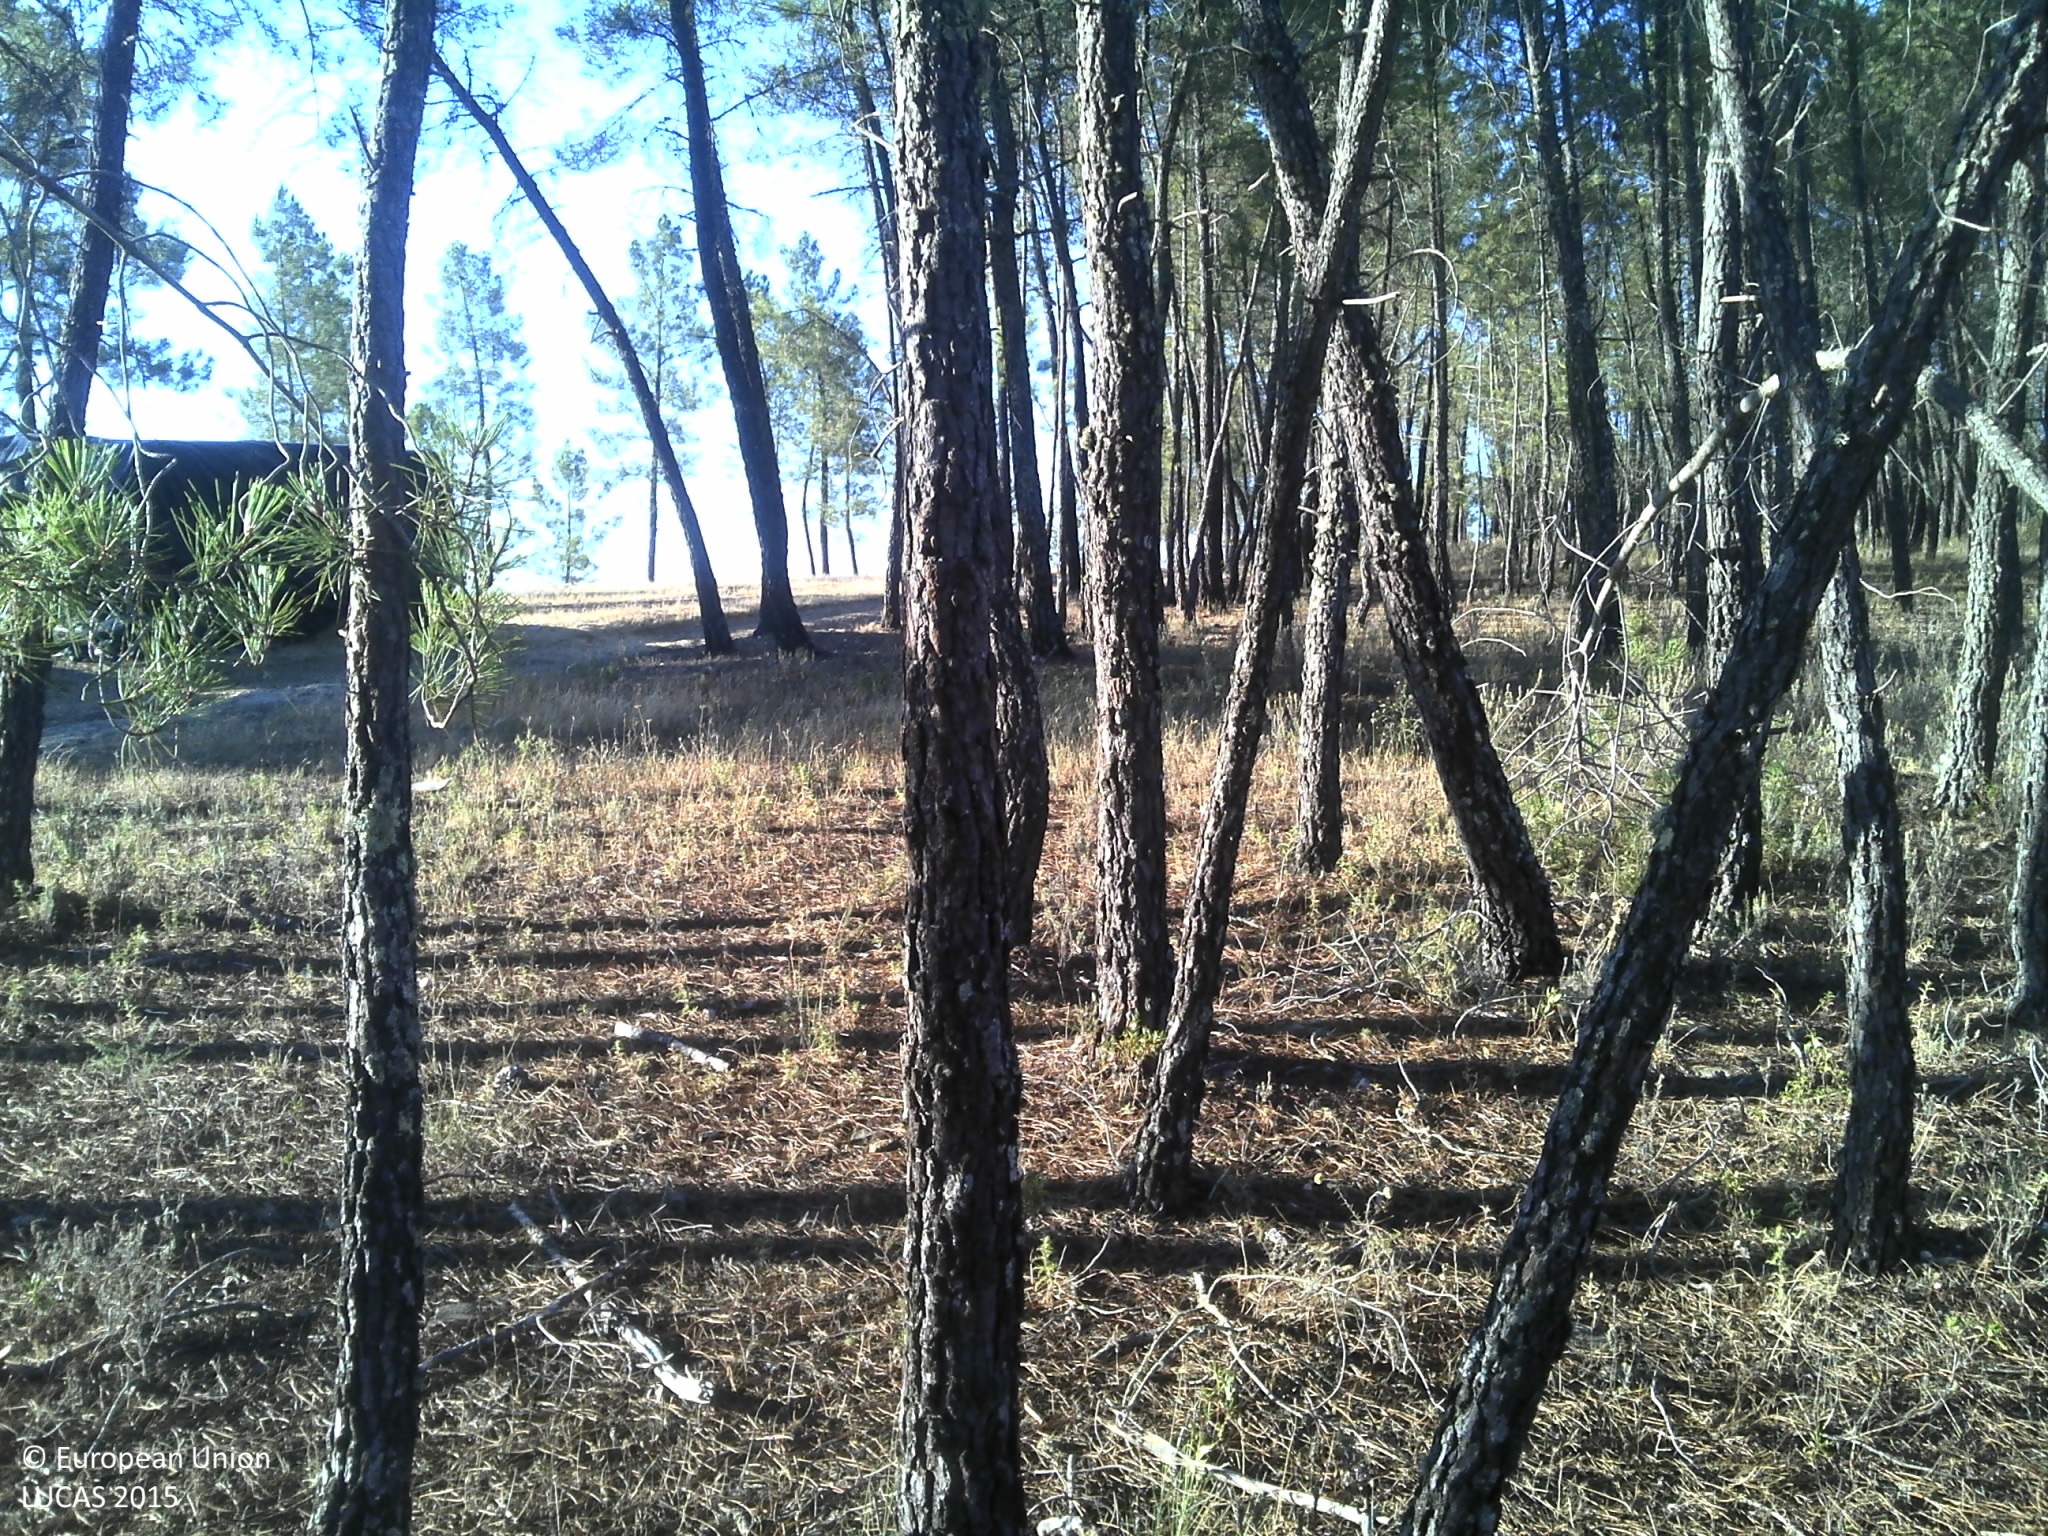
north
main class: Woodland
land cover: Pine dominated coniferous woodland
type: coniferous forest of the mediterranean region
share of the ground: 50 - 75 %
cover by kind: coniferous forest trees 70 %, unconsolidated bare surface 20 %, shrubs 5 %, herbaceous plants 5 %
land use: Forestry
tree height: > 5 m
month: July
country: PT
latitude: 39.9363
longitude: -7.5987
